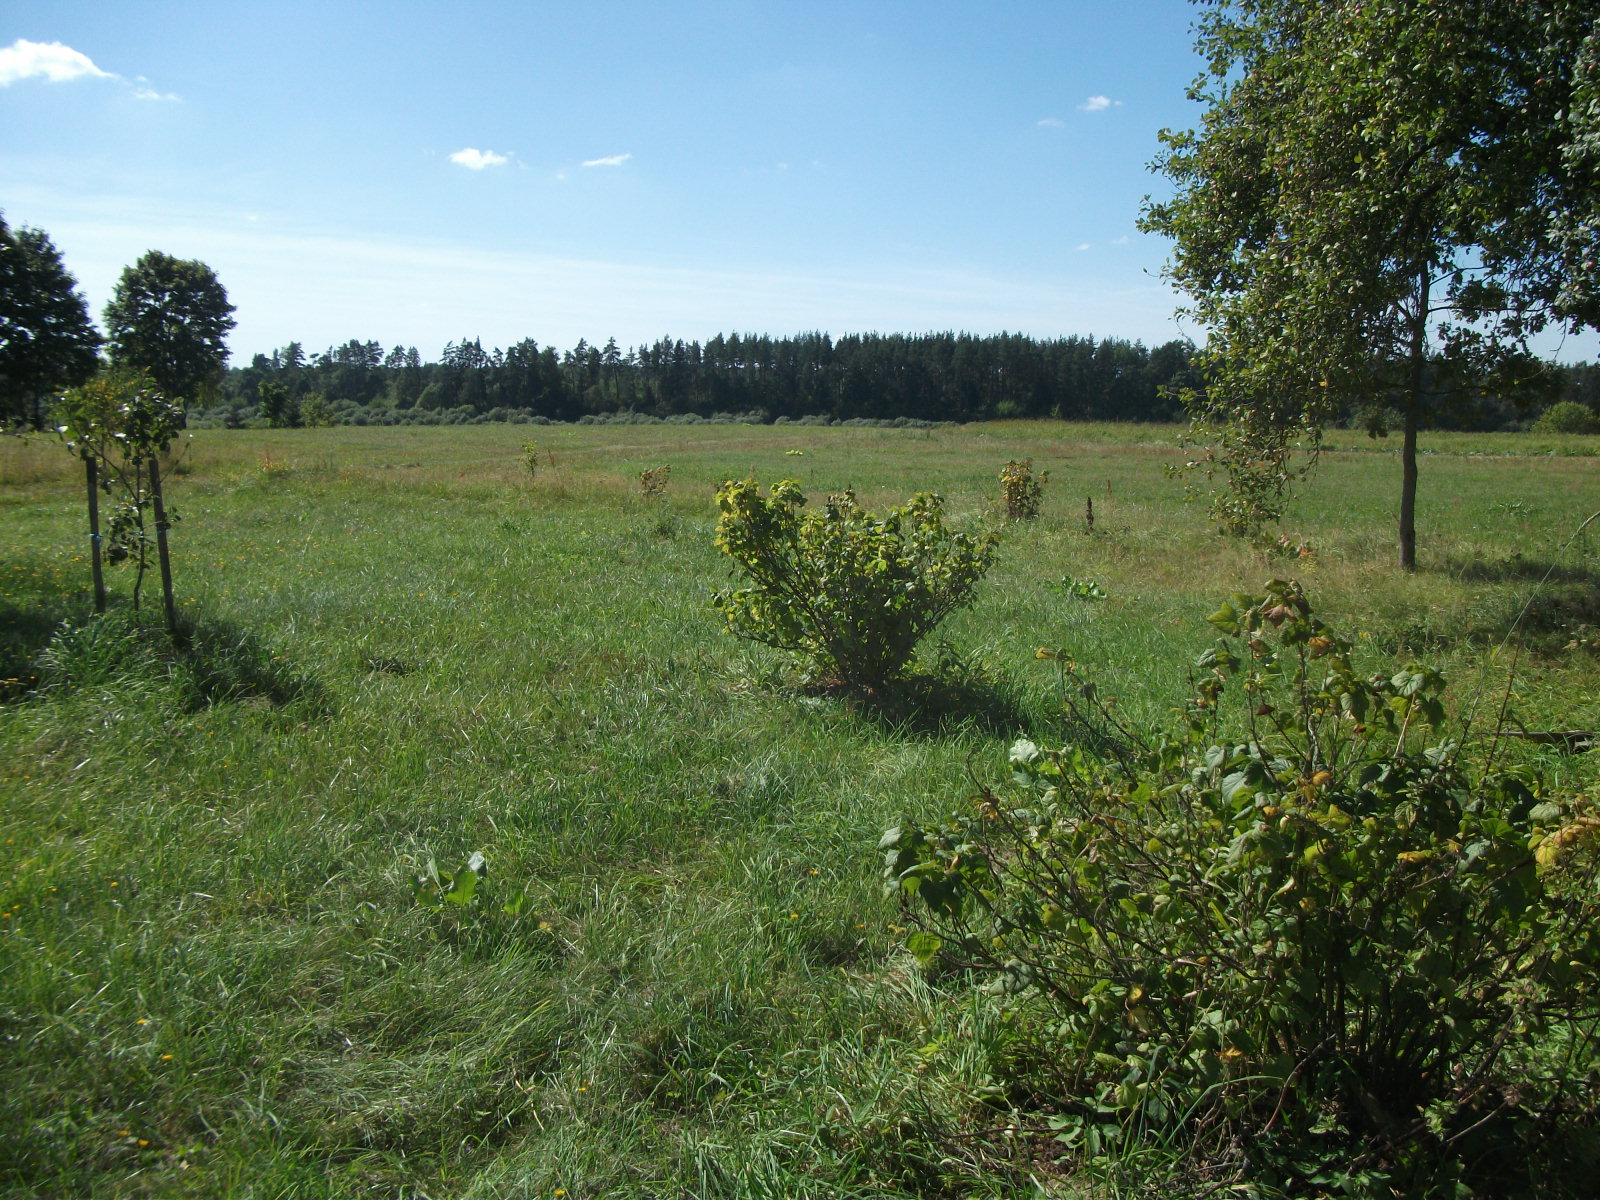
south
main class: Cropland
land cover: Apple fruit
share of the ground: 10 - 25 %
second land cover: Grassland without tree/shrub cover
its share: > 75 %
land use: Kitchen garden
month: August
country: LV
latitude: 56.4539
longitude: 26.0526
